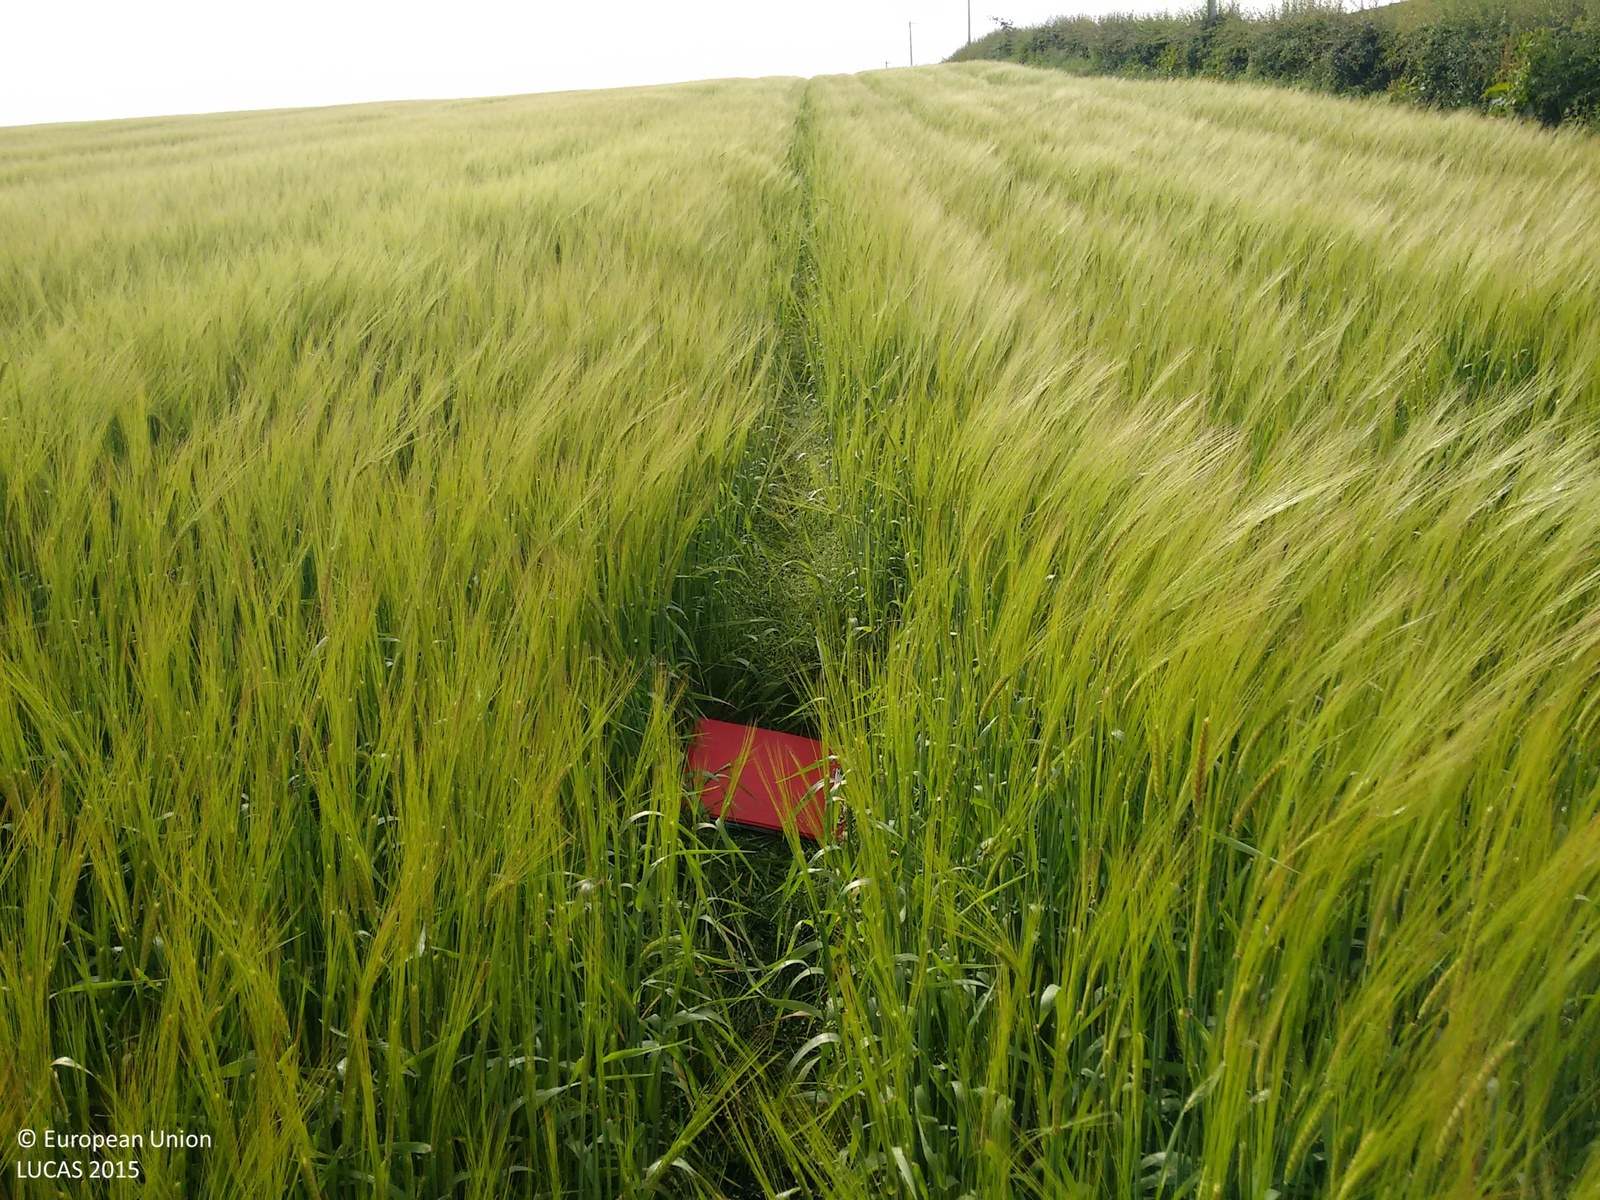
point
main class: Cropland
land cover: Barley
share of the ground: > 75 %
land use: Agriculture (excluding fallow land and kitchen gardens)
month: July
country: GB
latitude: 55.8534
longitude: -5.1130
